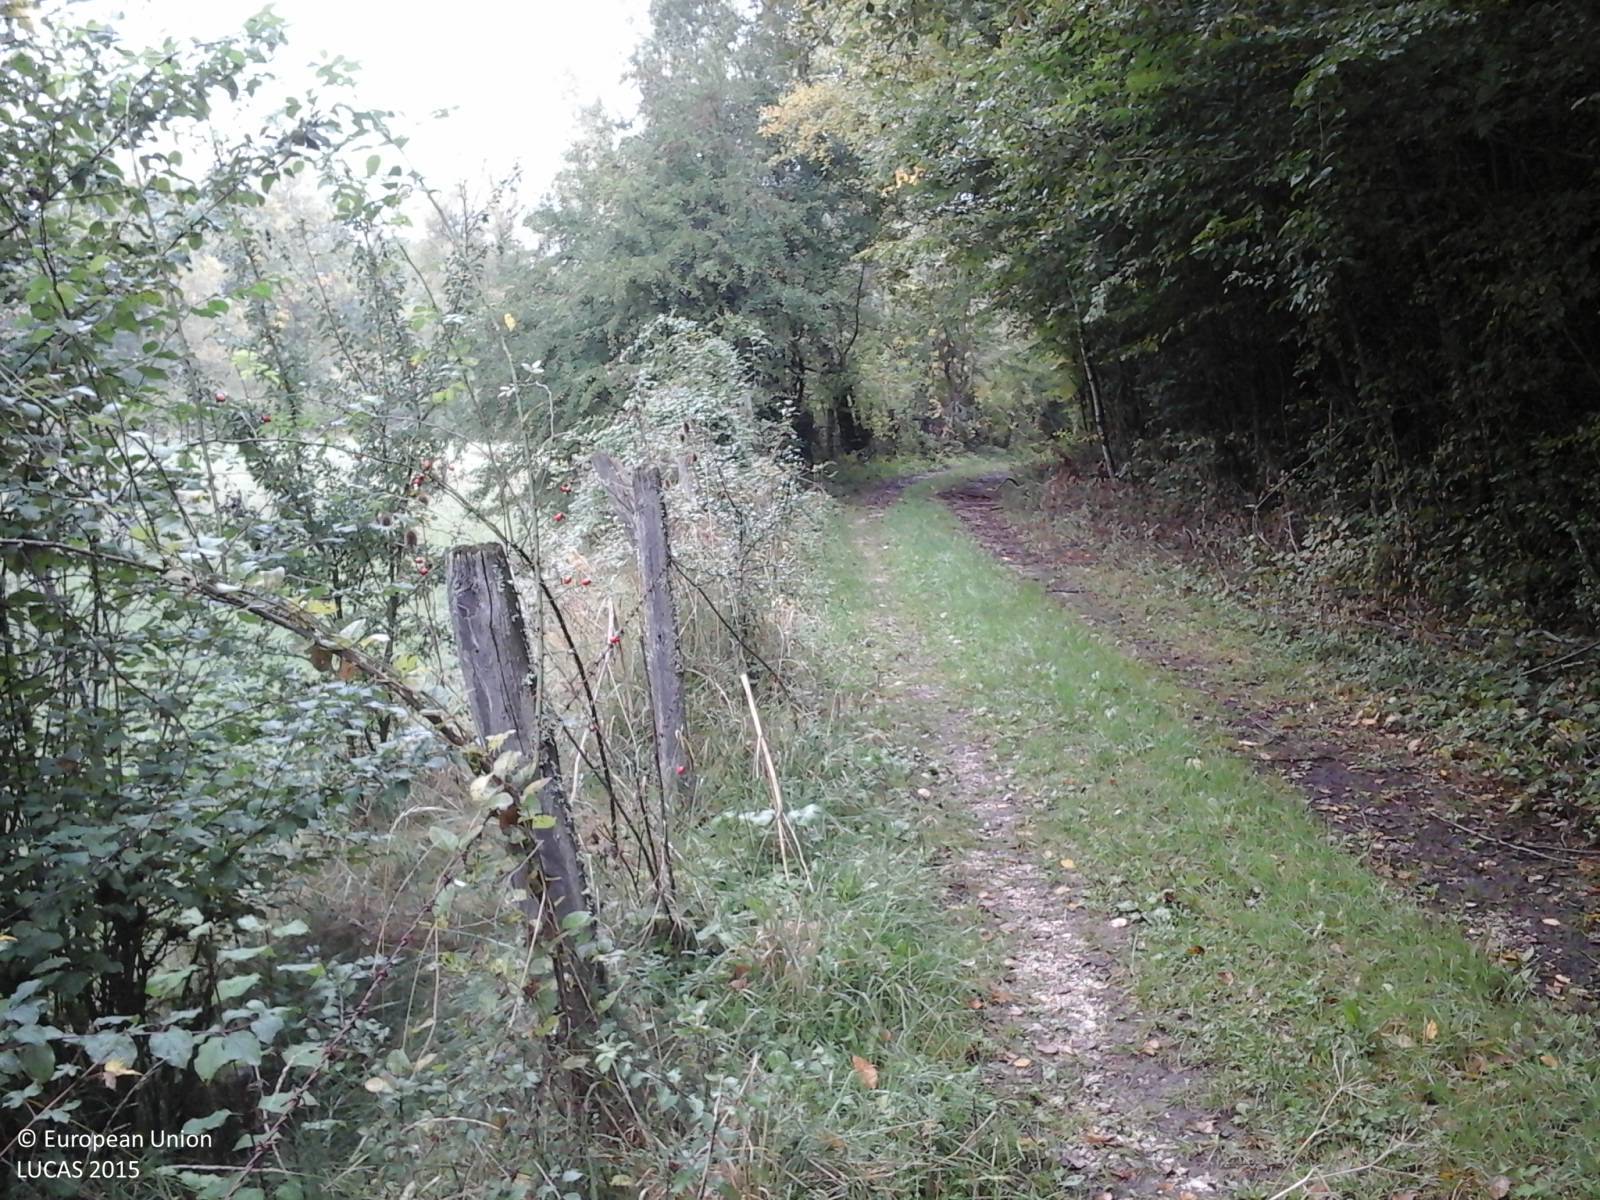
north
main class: Grassland
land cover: Grassland without tree/shrub cover
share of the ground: > 75 %
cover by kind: herbaceous plants 100 %
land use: Agriculture (excluding fallow land and kitchen gardens)
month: October
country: IT
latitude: 42.6021
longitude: 13.2443
